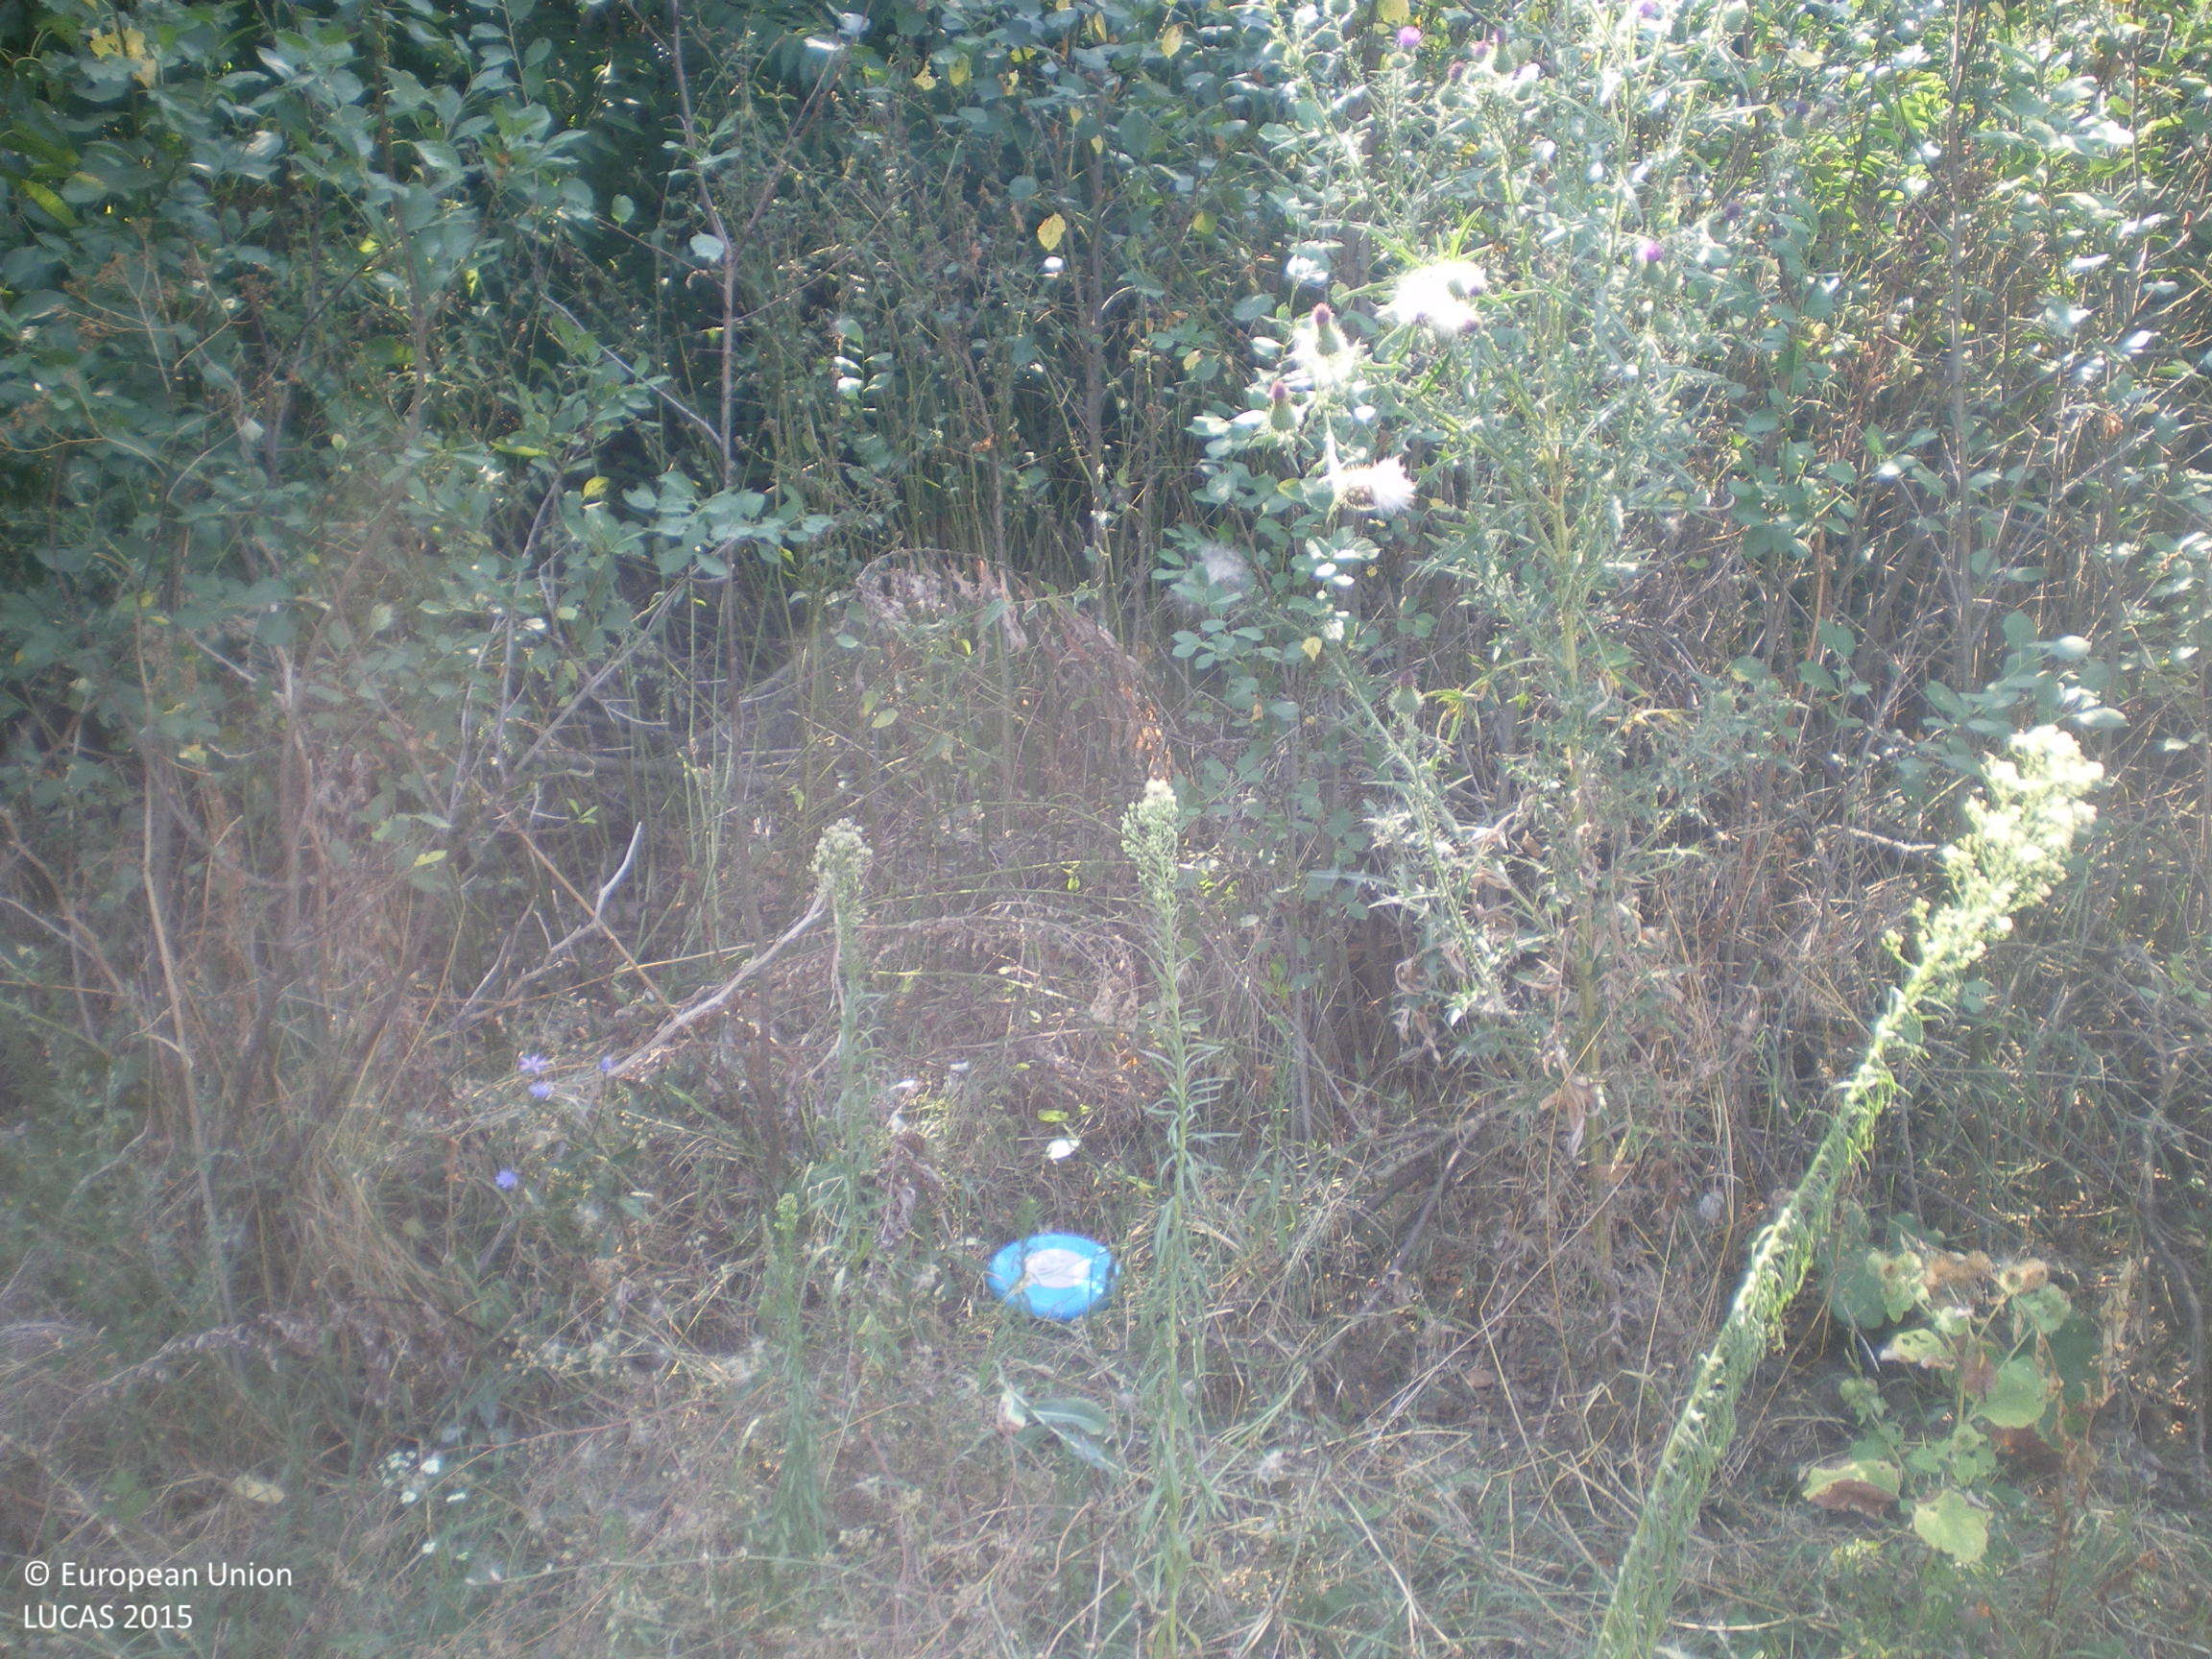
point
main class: Woodland
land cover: Broadleaved woodland
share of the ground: > 75 %
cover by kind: broadleaved forest trees 80 %, shrubs 10 %, herbaceous plants 10 %
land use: Residential
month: August
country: BG
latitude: 42.3362
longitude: 25.7171
